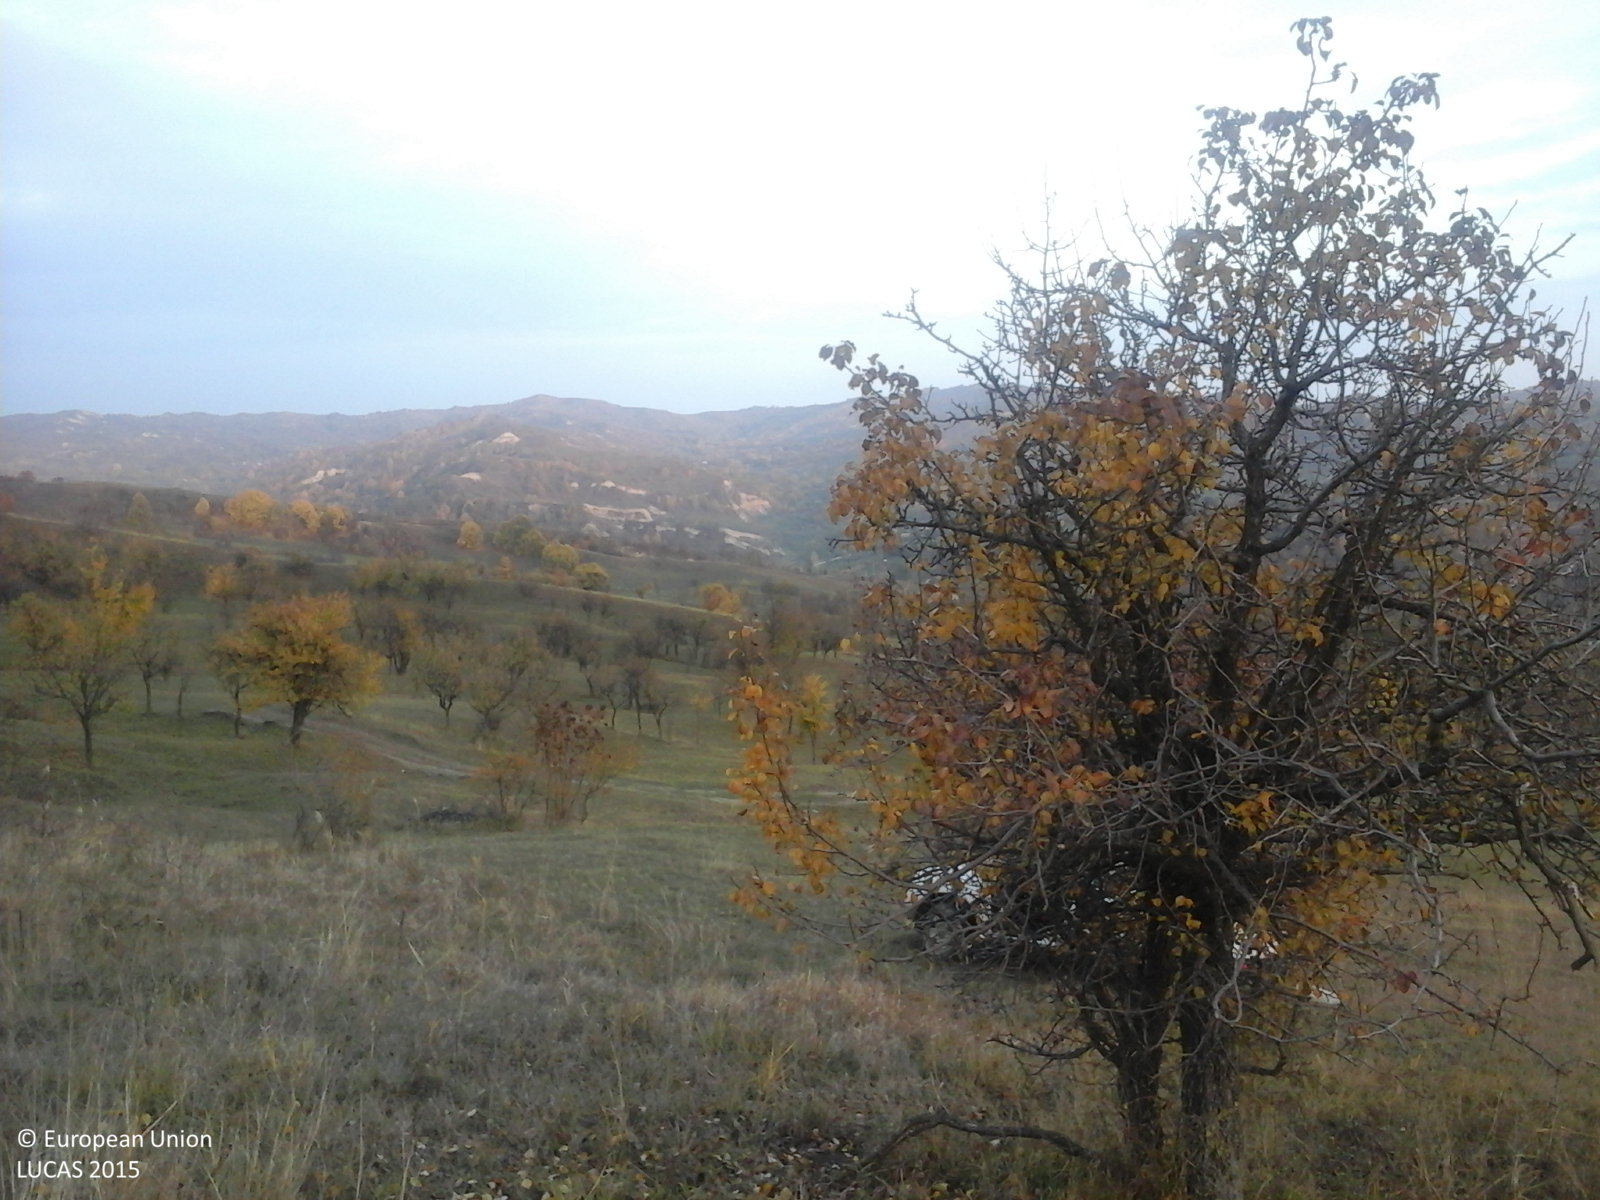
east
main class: Grassland
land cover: Grassland with sparse tree/shrub cover
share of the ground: > 75 %
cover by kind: herbaceous plants 95 %, broadleaved forest trees 5 %
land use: Agriculture (excluding fallow land and kitchen gardens)
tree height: > 5 m
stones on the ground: < 10 %
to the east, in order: Grassland with sparse tree/shrub cover; Tracks; Other fruit trees and berries; Tracks; Other fruit trees and berries
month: October
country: RO
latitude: 45.4779
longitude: 26.7496
